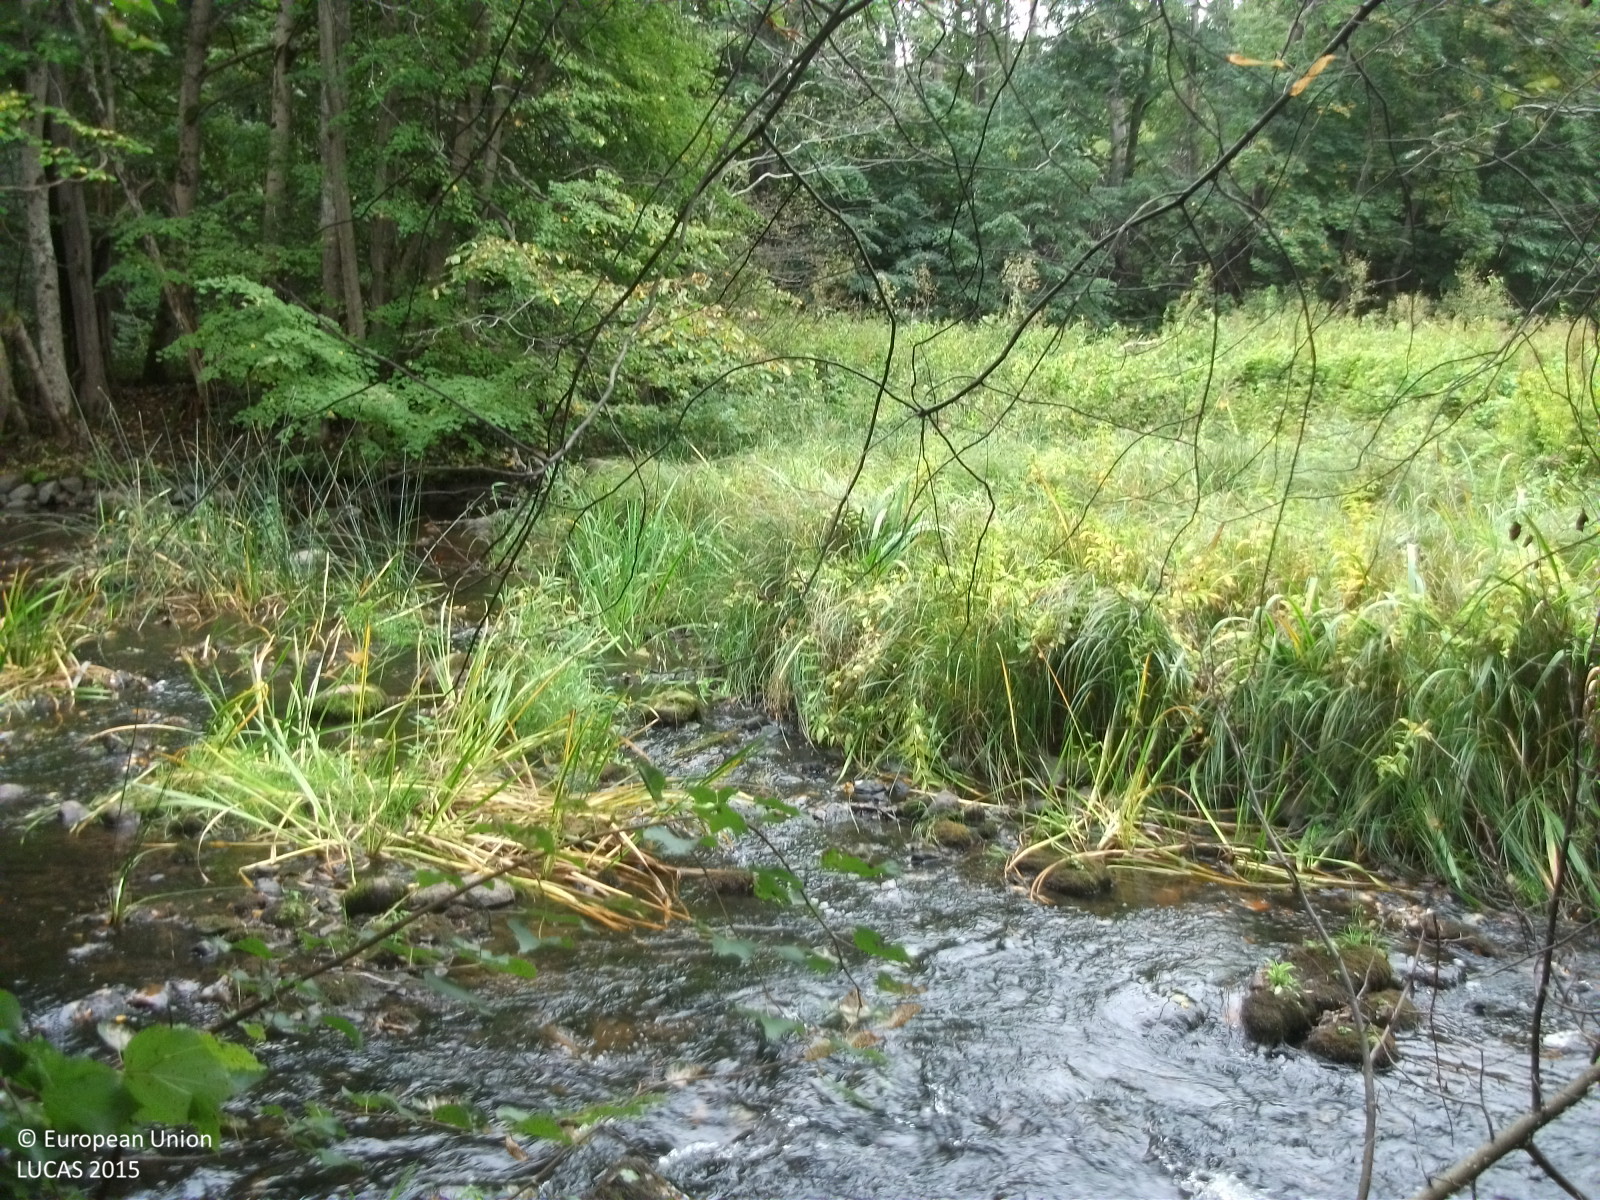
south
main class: Grassland
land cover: Spontaneously vegetated surfaces
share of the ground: > 75 %
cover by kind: herbaceous plants 100 %
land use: Semi-natural and natural areas not in use
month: September
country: LV
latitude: 57.6525
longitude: 24.4500
